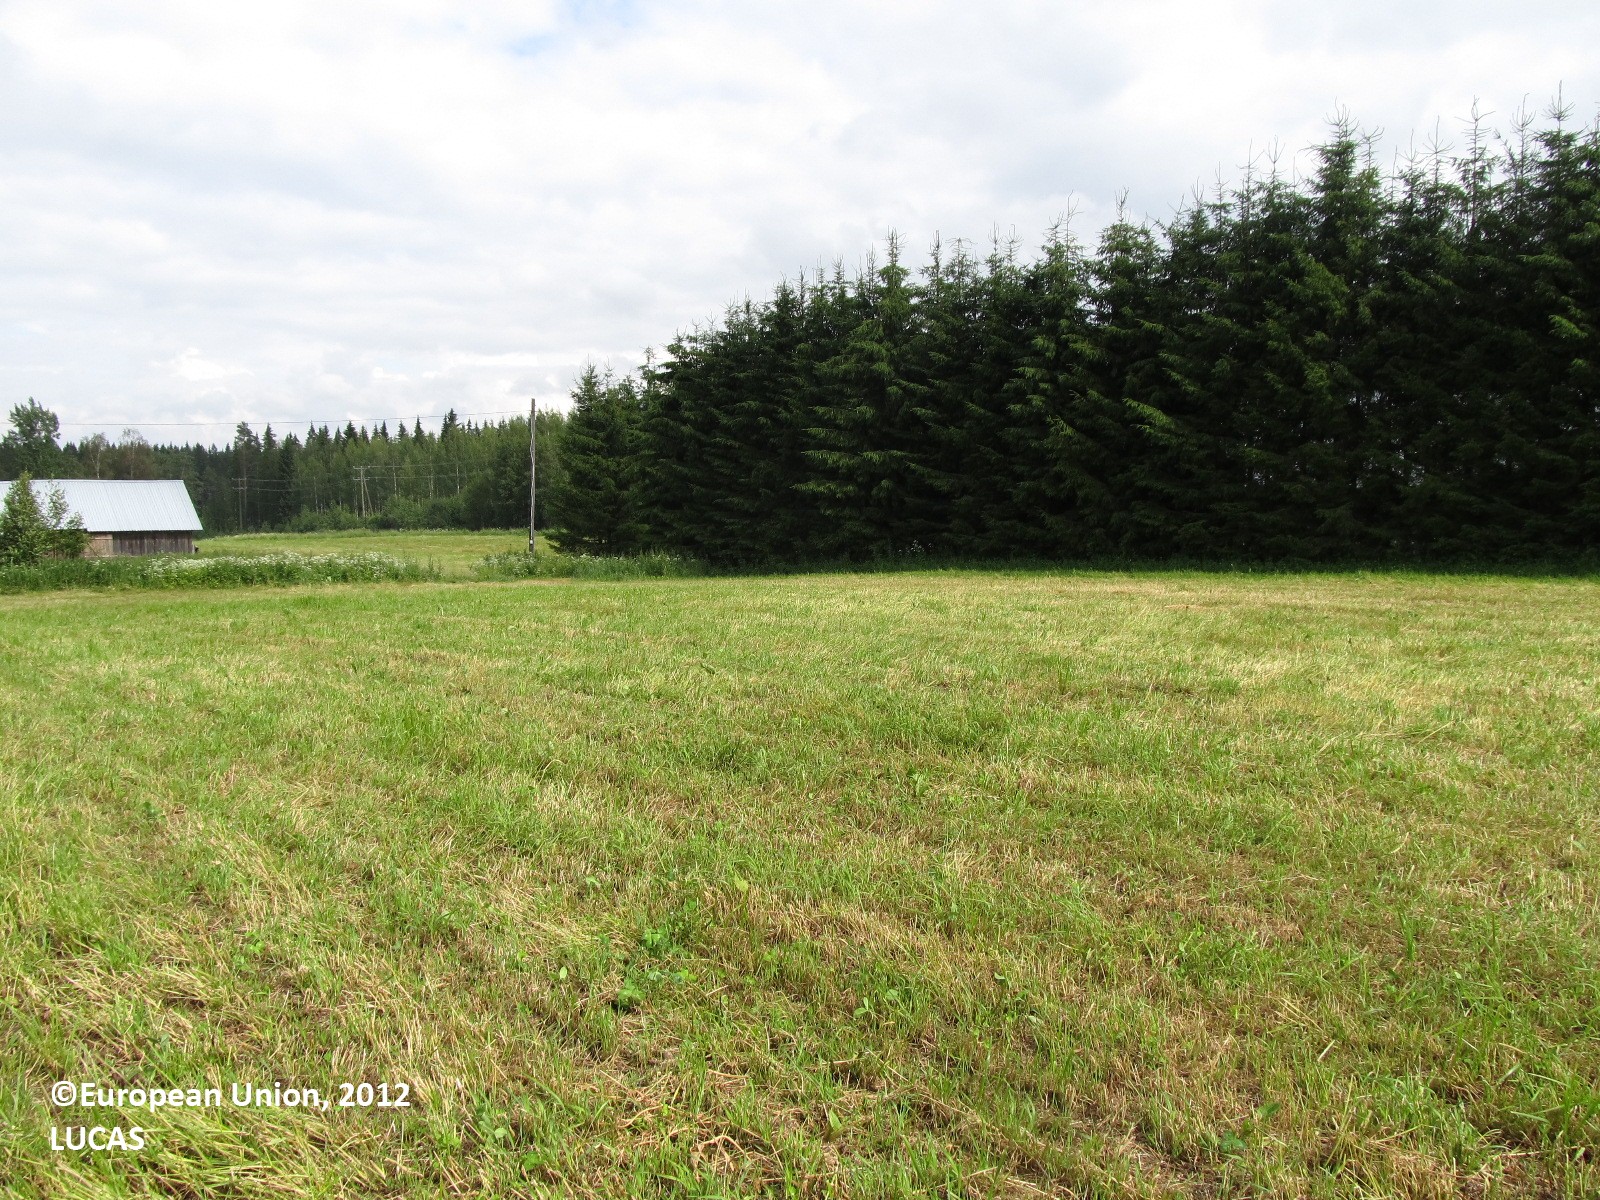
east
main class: Grassland
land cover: Grassland without tree/shrub cover
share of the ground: 50 - 75 %
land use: Fallow land
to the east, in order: Grassland without tree/shrub cover; Lines of trees; Artificial constructions in urban areas; Lines of trees; Grassland without tree/shrub cover; Ditches and canals; Grass margins; Paved roads, cycling and walking lanes; Grass margins; Ditches and canals; Grassland without tree/shrub cover; Electric lines; Spruce dominated coniferous woodland; Spruce dominated mixed woodland
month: July
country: FI
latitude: 61.9196
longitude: 28.3113
